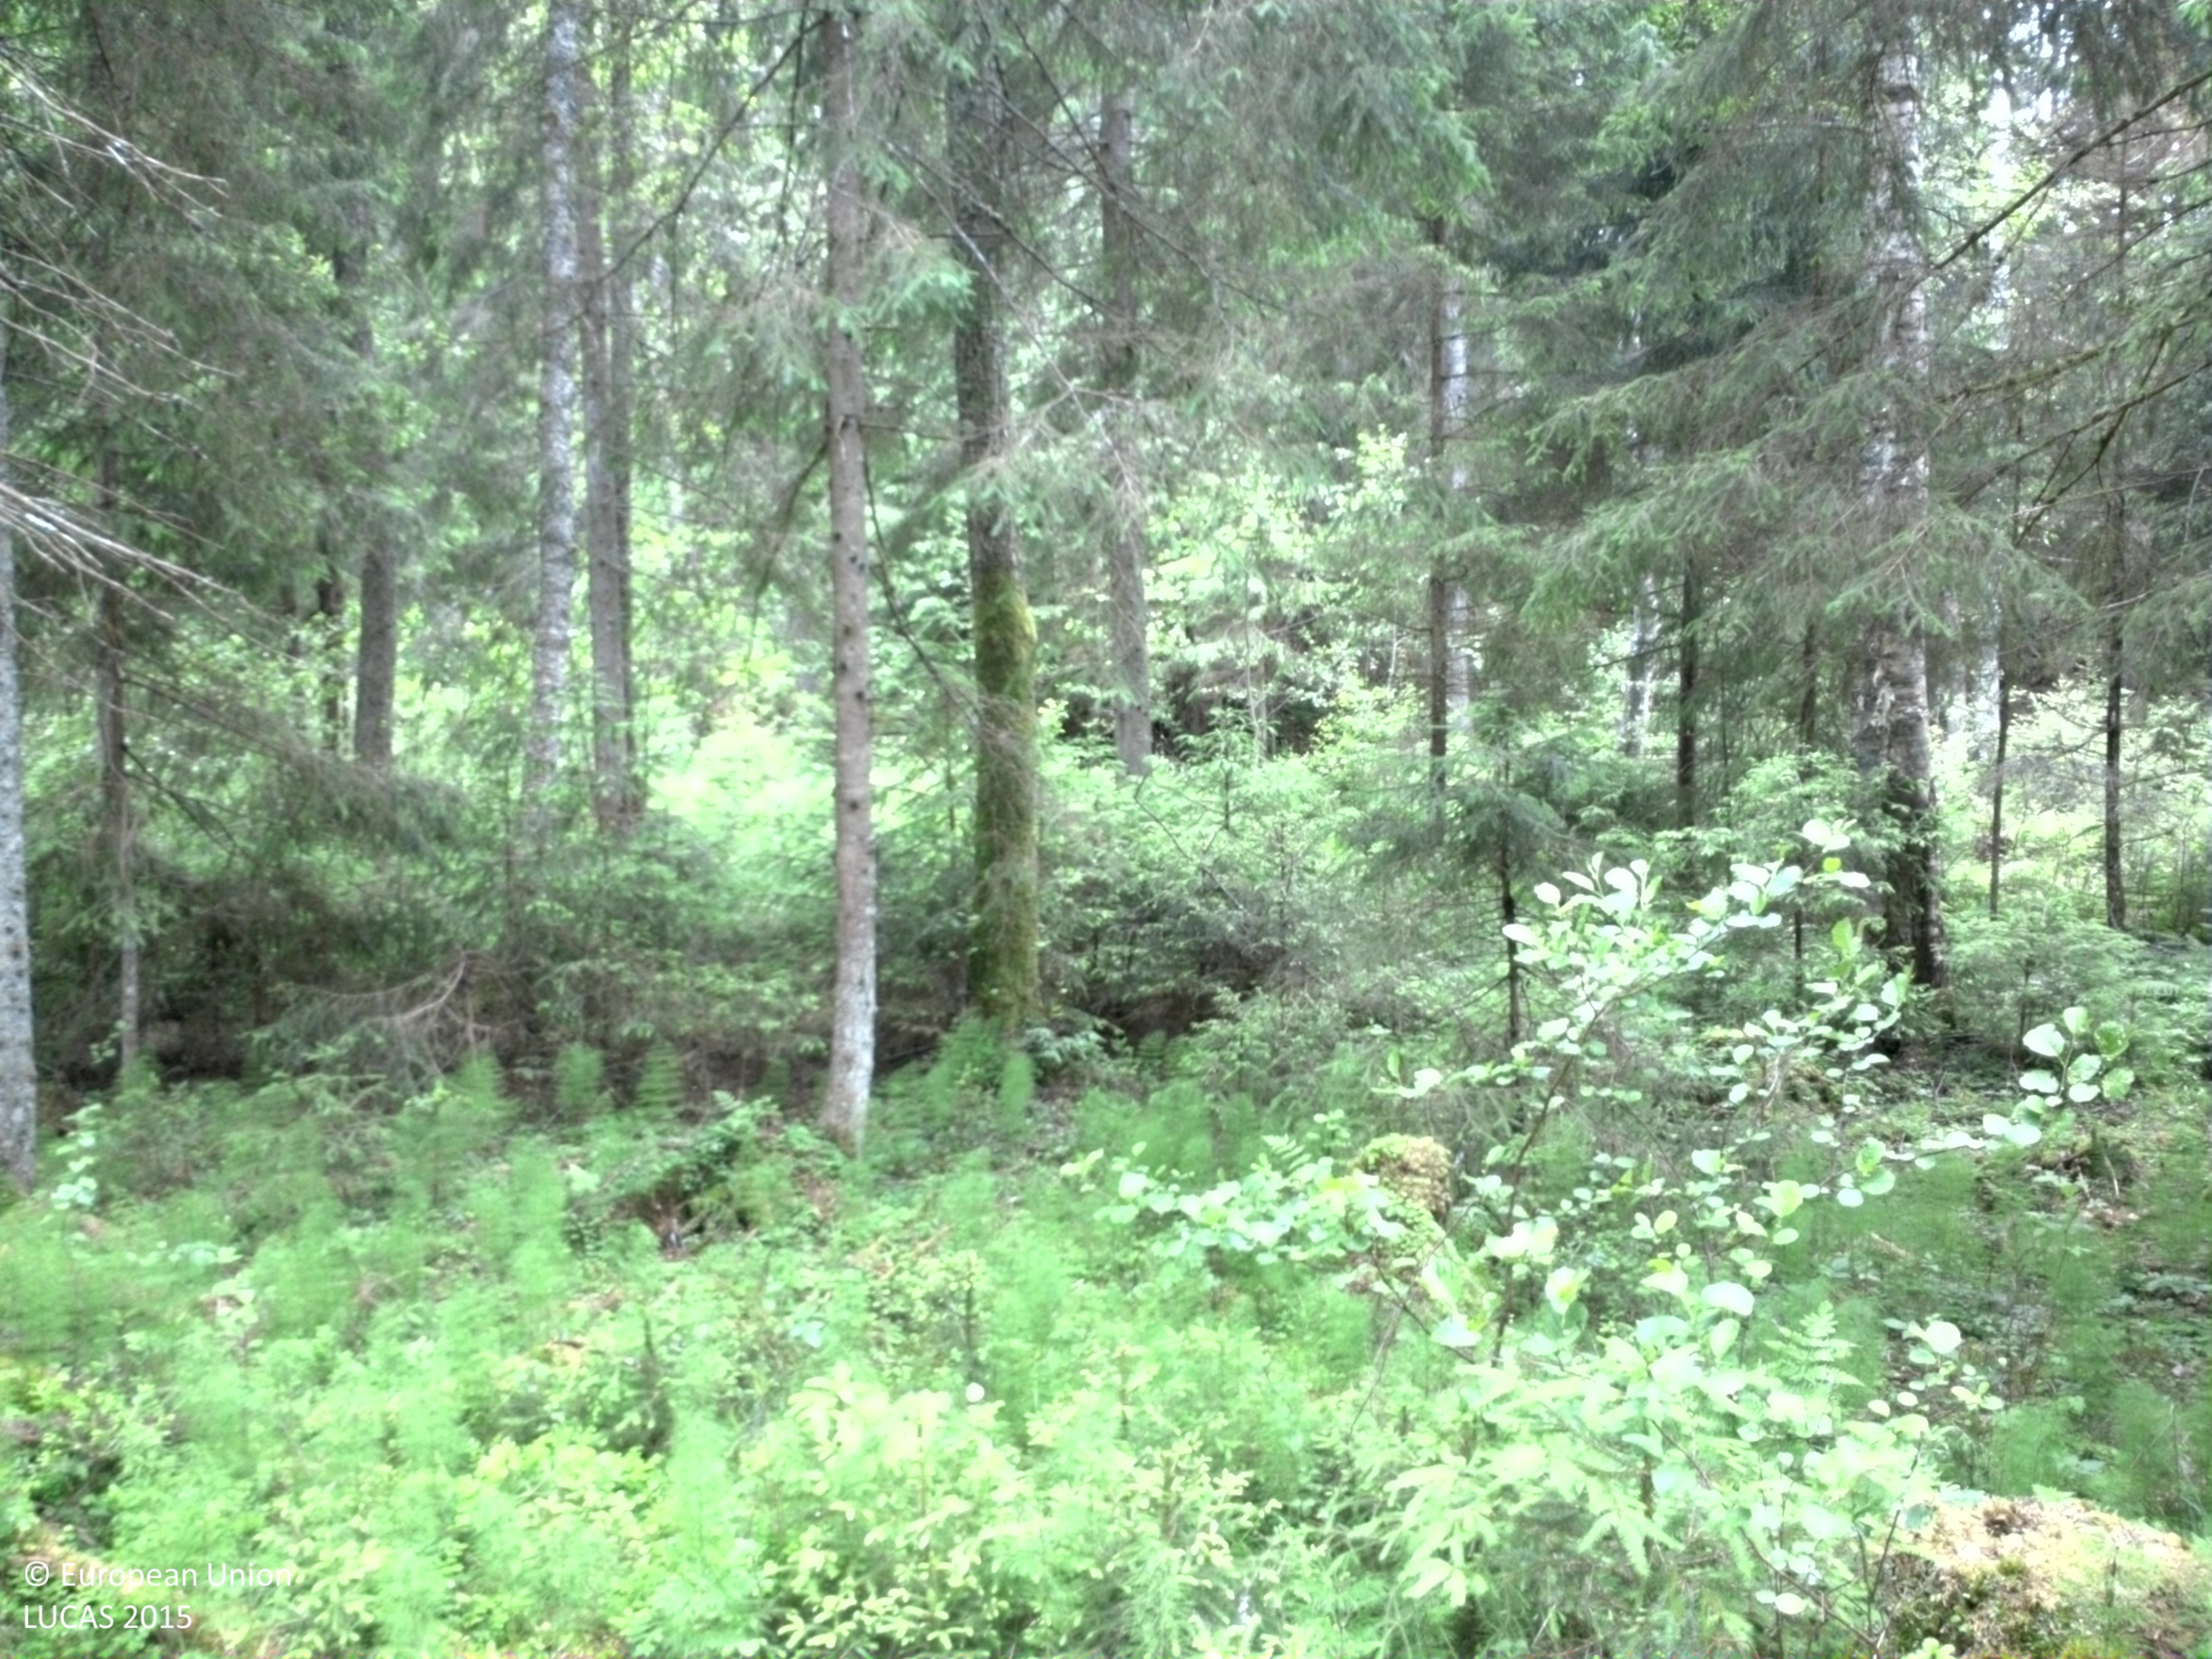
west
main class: Woodland
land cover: Spruce dominated coniferous woodland
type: boreal forest
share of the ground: 25 - 50 %
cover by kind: herbaceous plants 55 %, coniferous forest trees 30 %, lichens and mosses 10 %, broadleaved forest trees 5 %
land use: Forestry
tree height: > 5 m
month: June
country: SE
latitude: 58.6980
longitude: 15.6021
